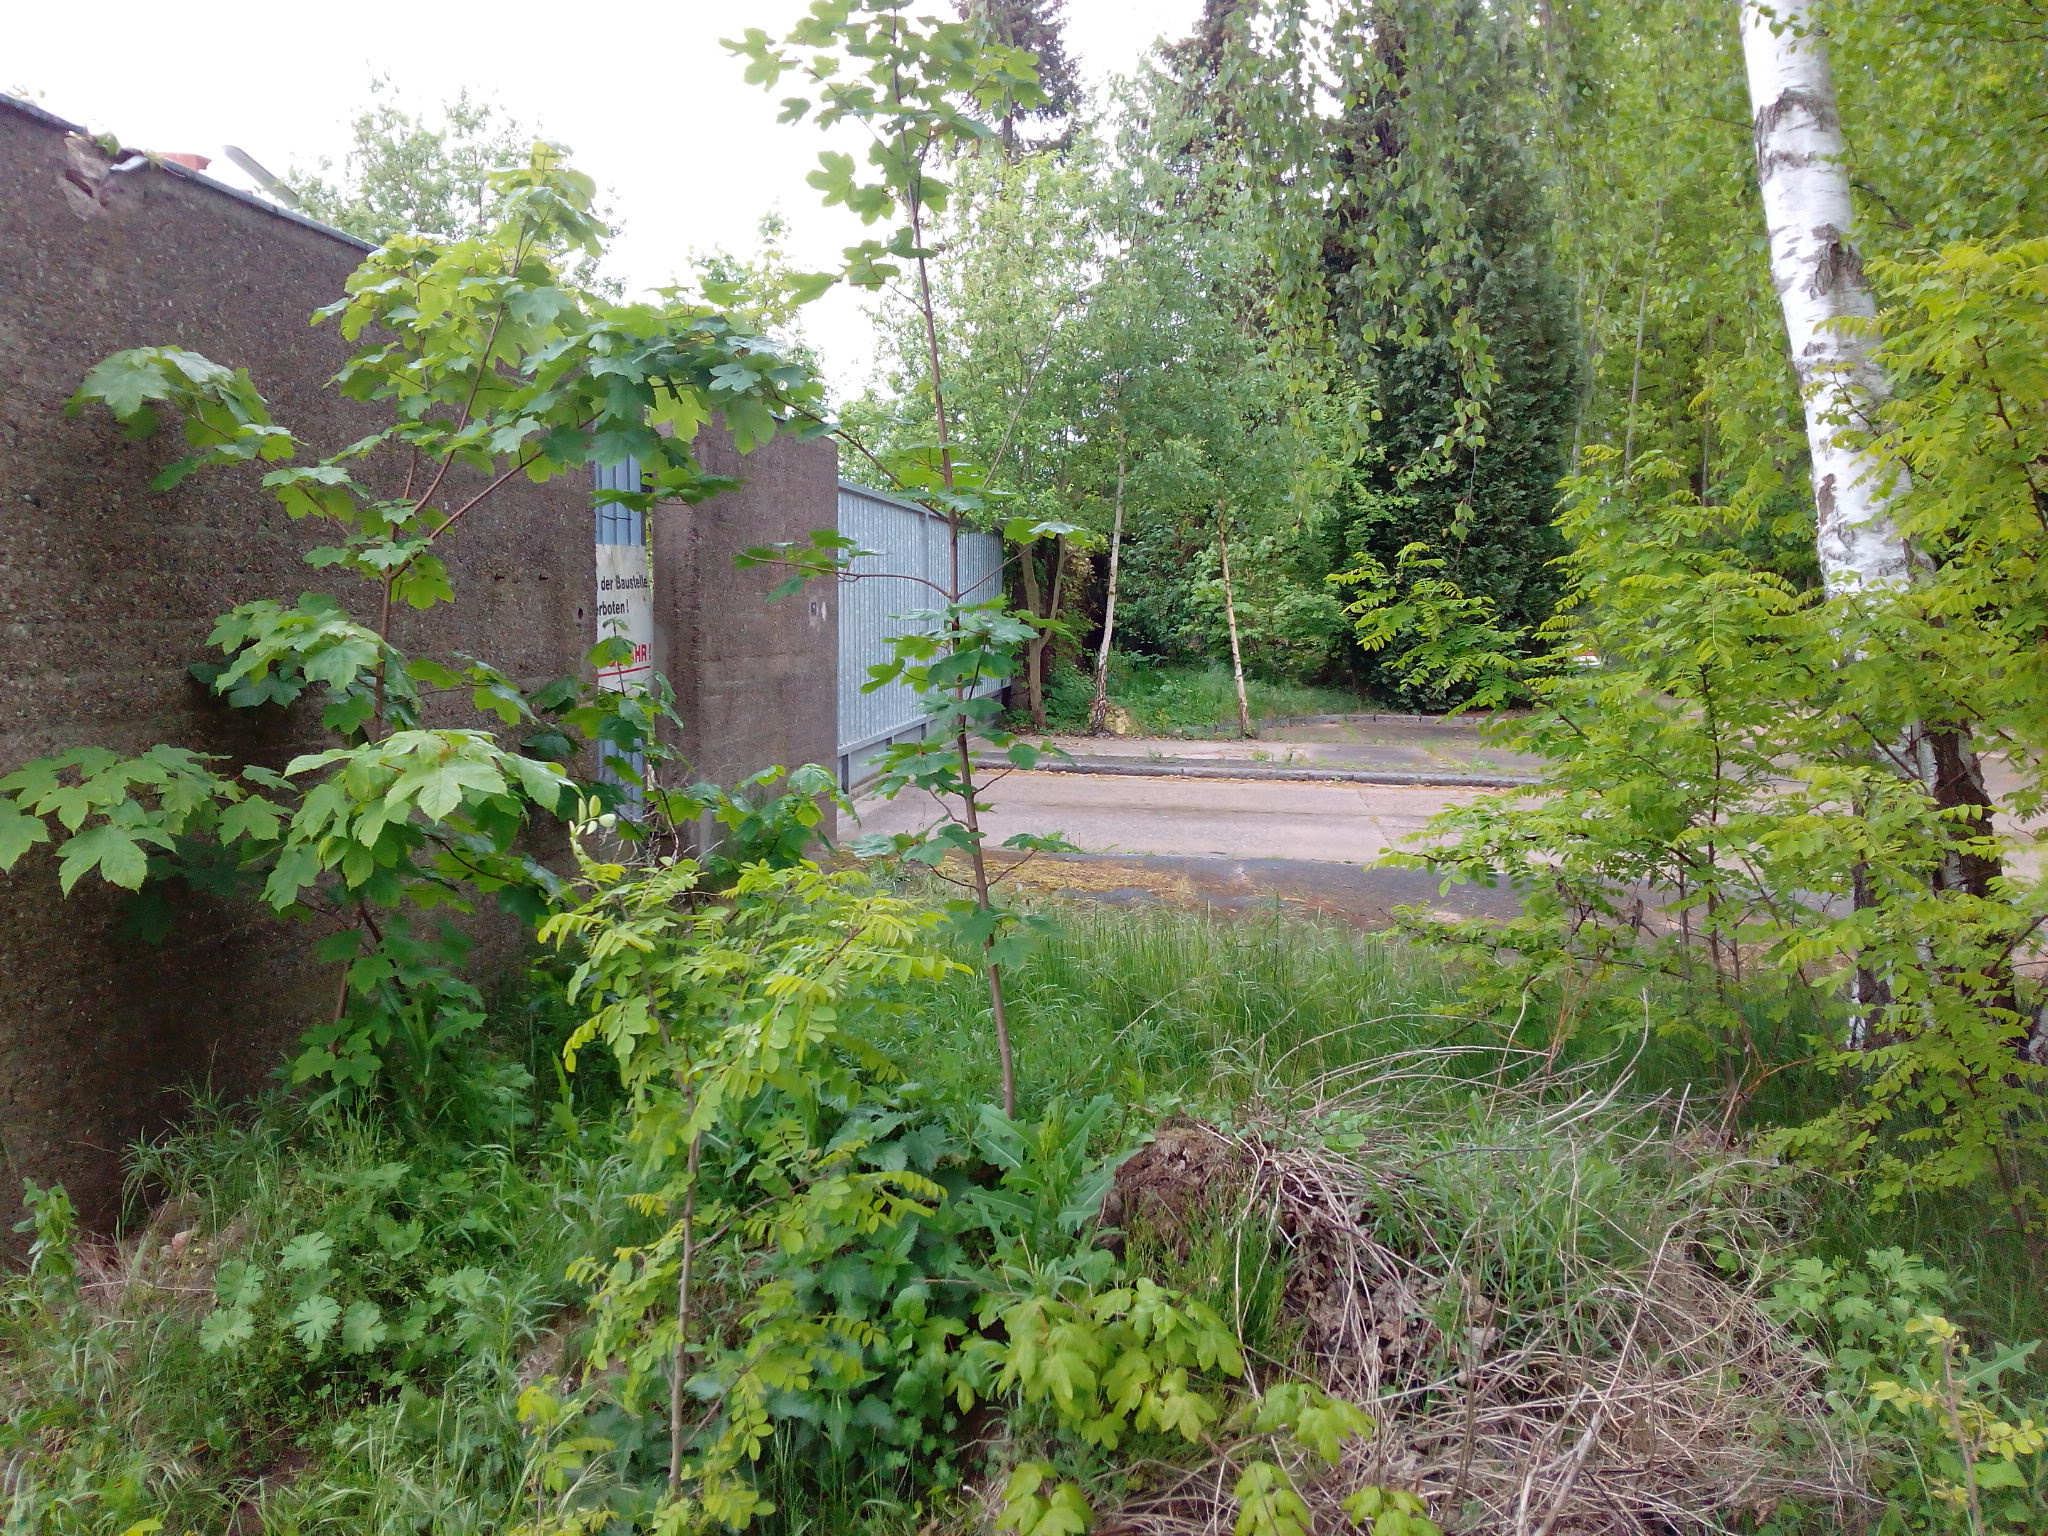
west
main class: Grassland
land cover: Spontaneously vegetated surfaces
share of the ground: > 75 %
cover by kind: herbaceous plants 90 %, shrubs 5 %, consolidated bare surface 5 %
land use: Abandoned areas
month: May
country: DE
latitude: 52.8242
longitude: 9.2138
